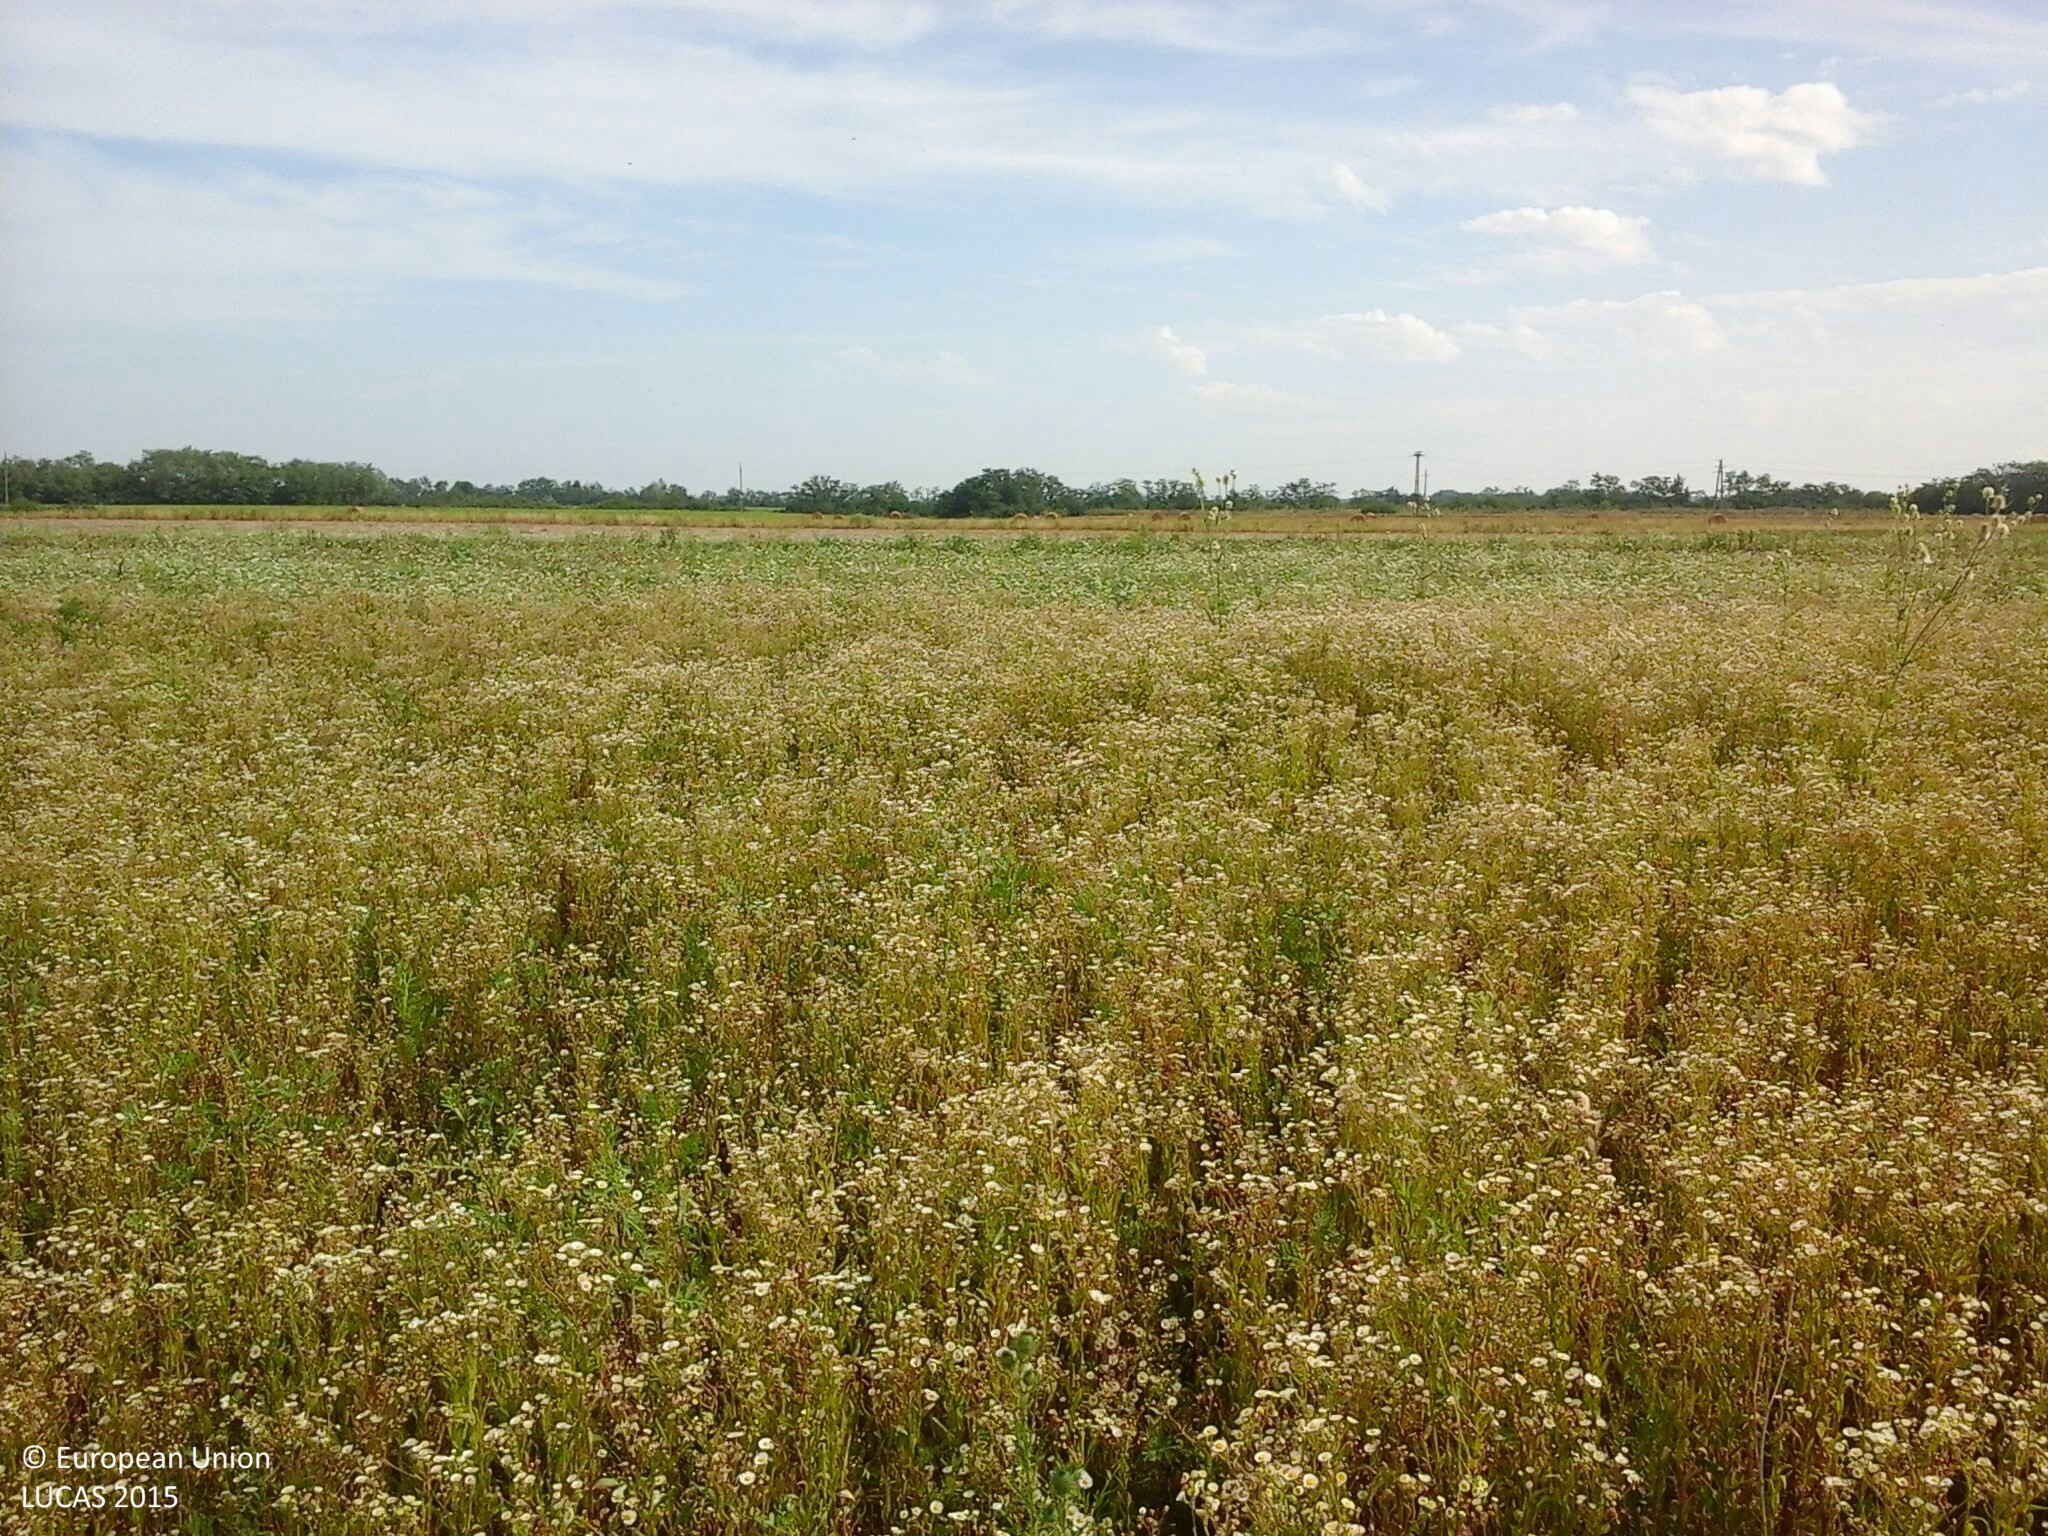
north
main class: Grassland
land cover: Spontaneously vegetated surfaces
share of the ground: > 75 %
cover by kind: herbaceous plants 100 %
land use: Abandoned areas
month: July
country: HU
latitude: 48.2210
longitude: 22.3199
